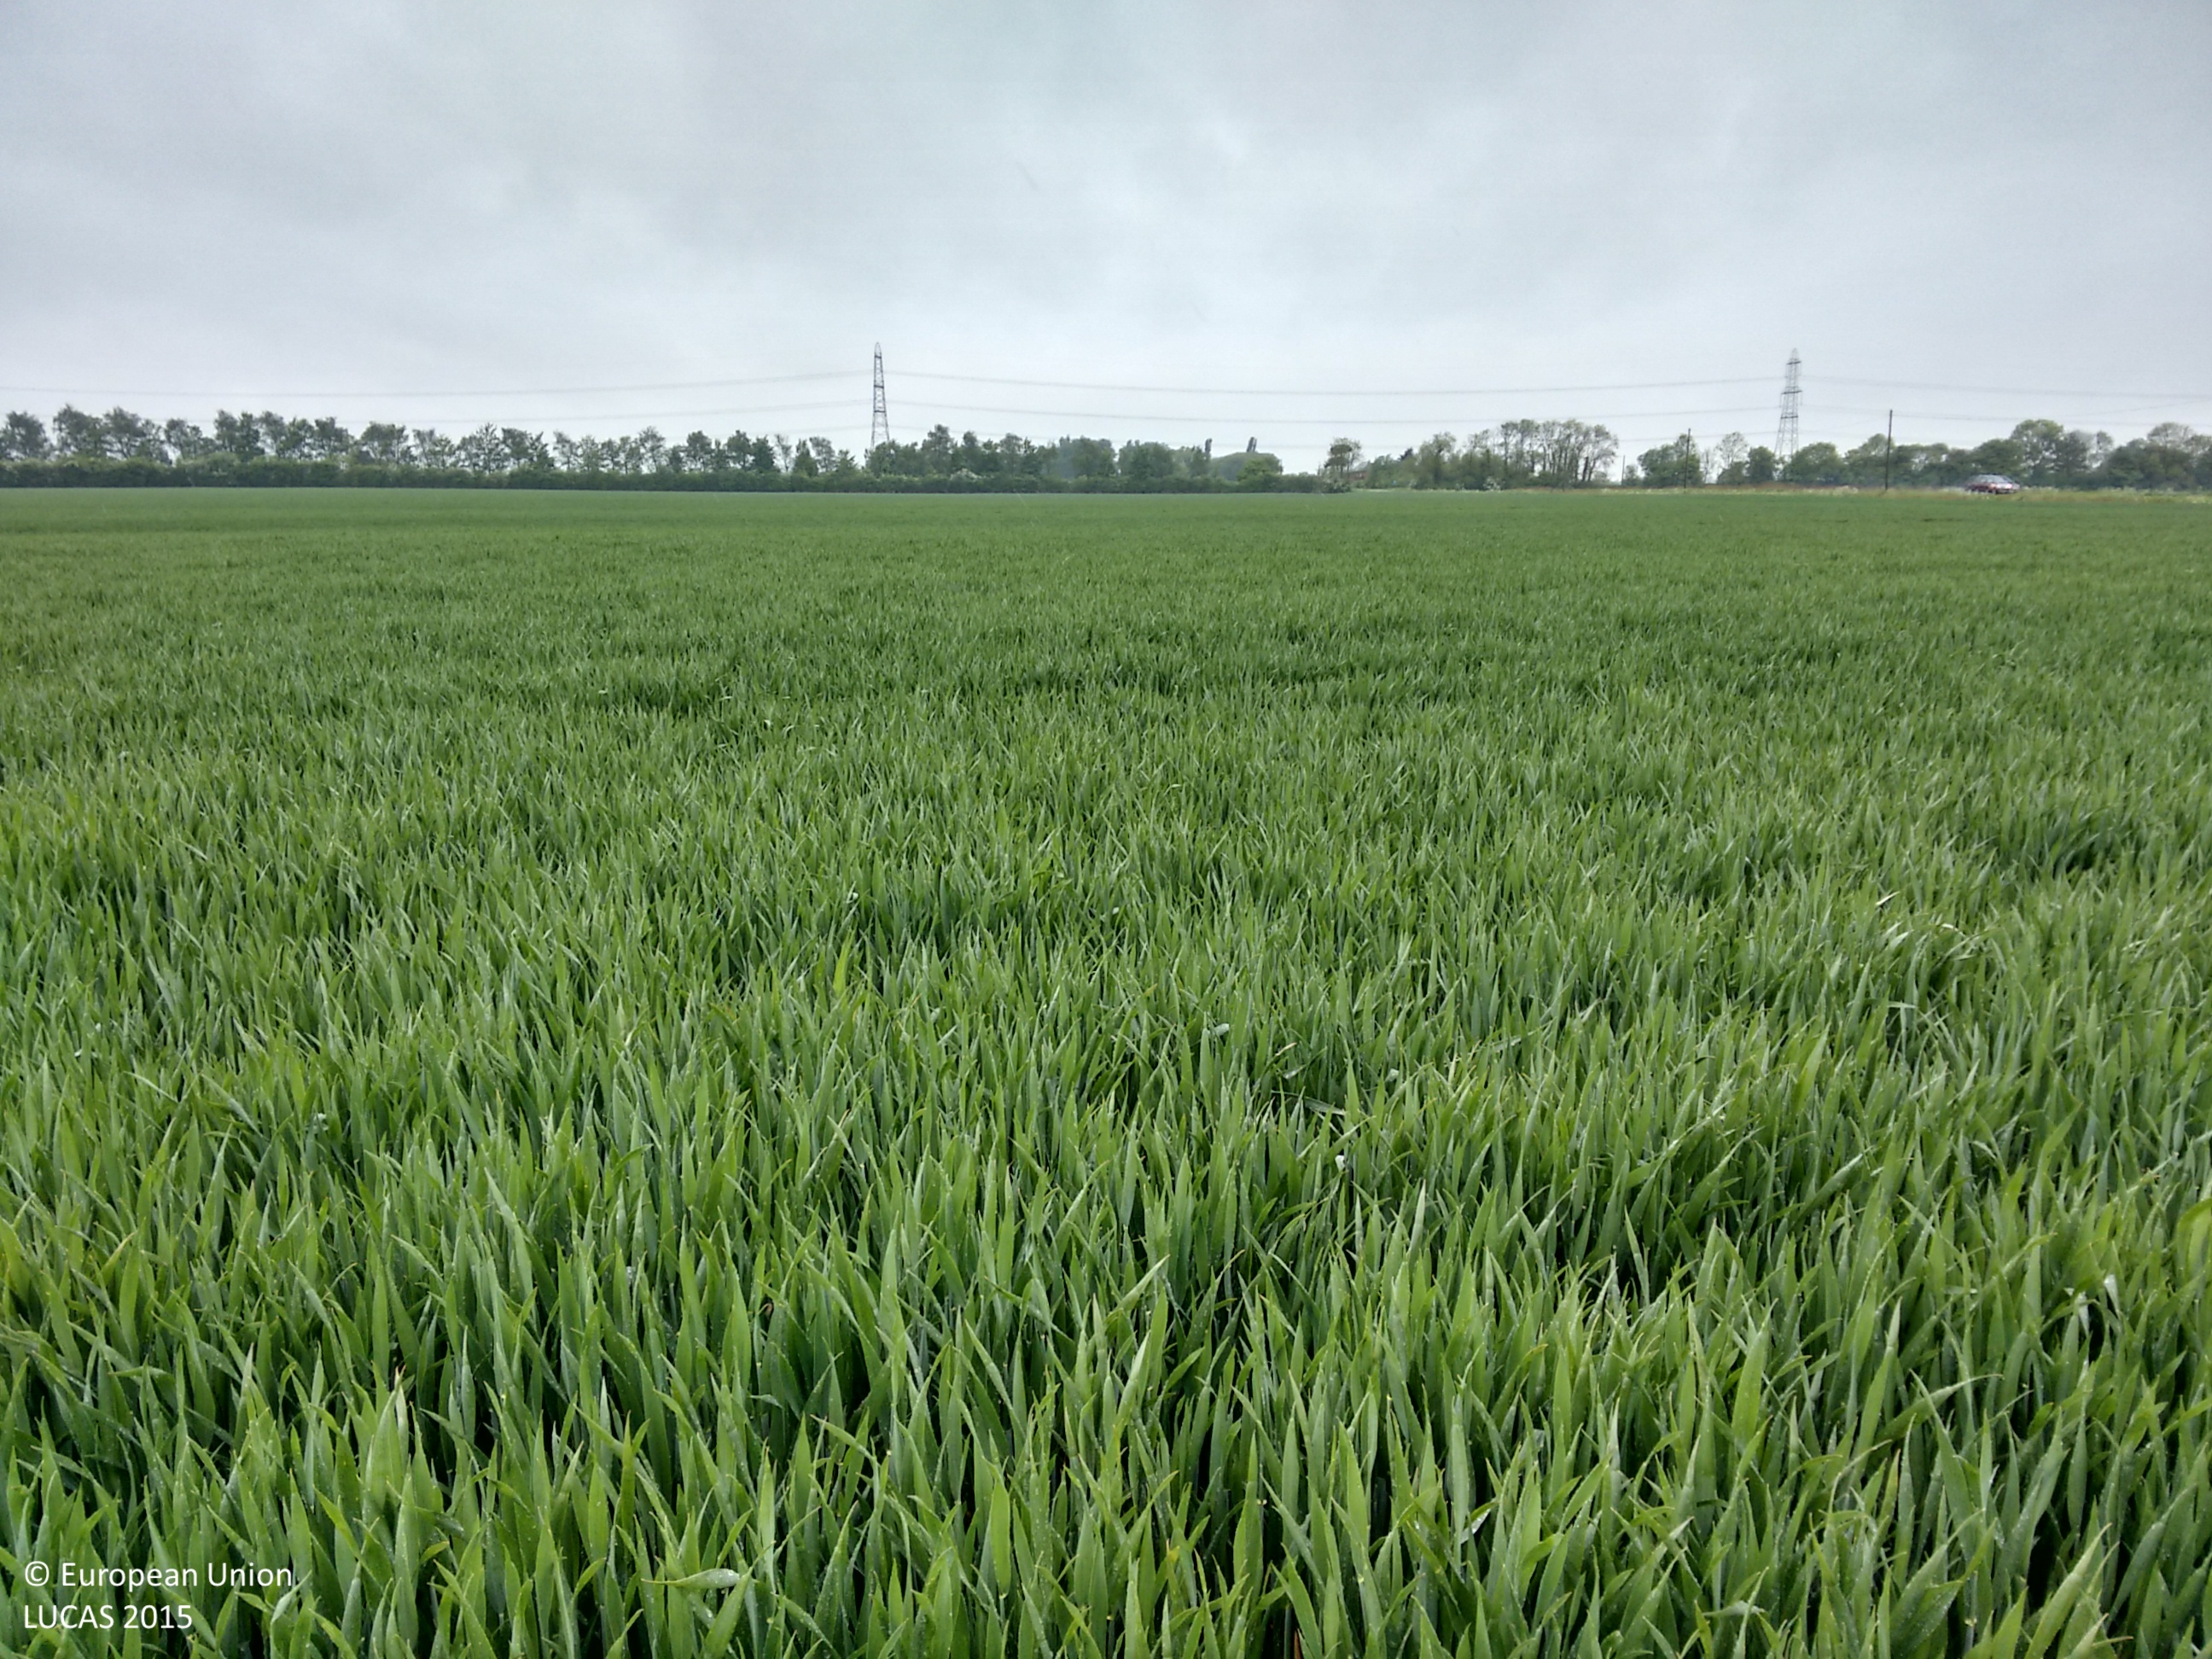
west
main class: Cropland
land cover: Common wheat
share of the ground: > 75 %
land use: Agriculture (excluding fallow land and kitchen gardens)
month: May
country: GB
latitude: 52.8859
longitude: -0.1245
